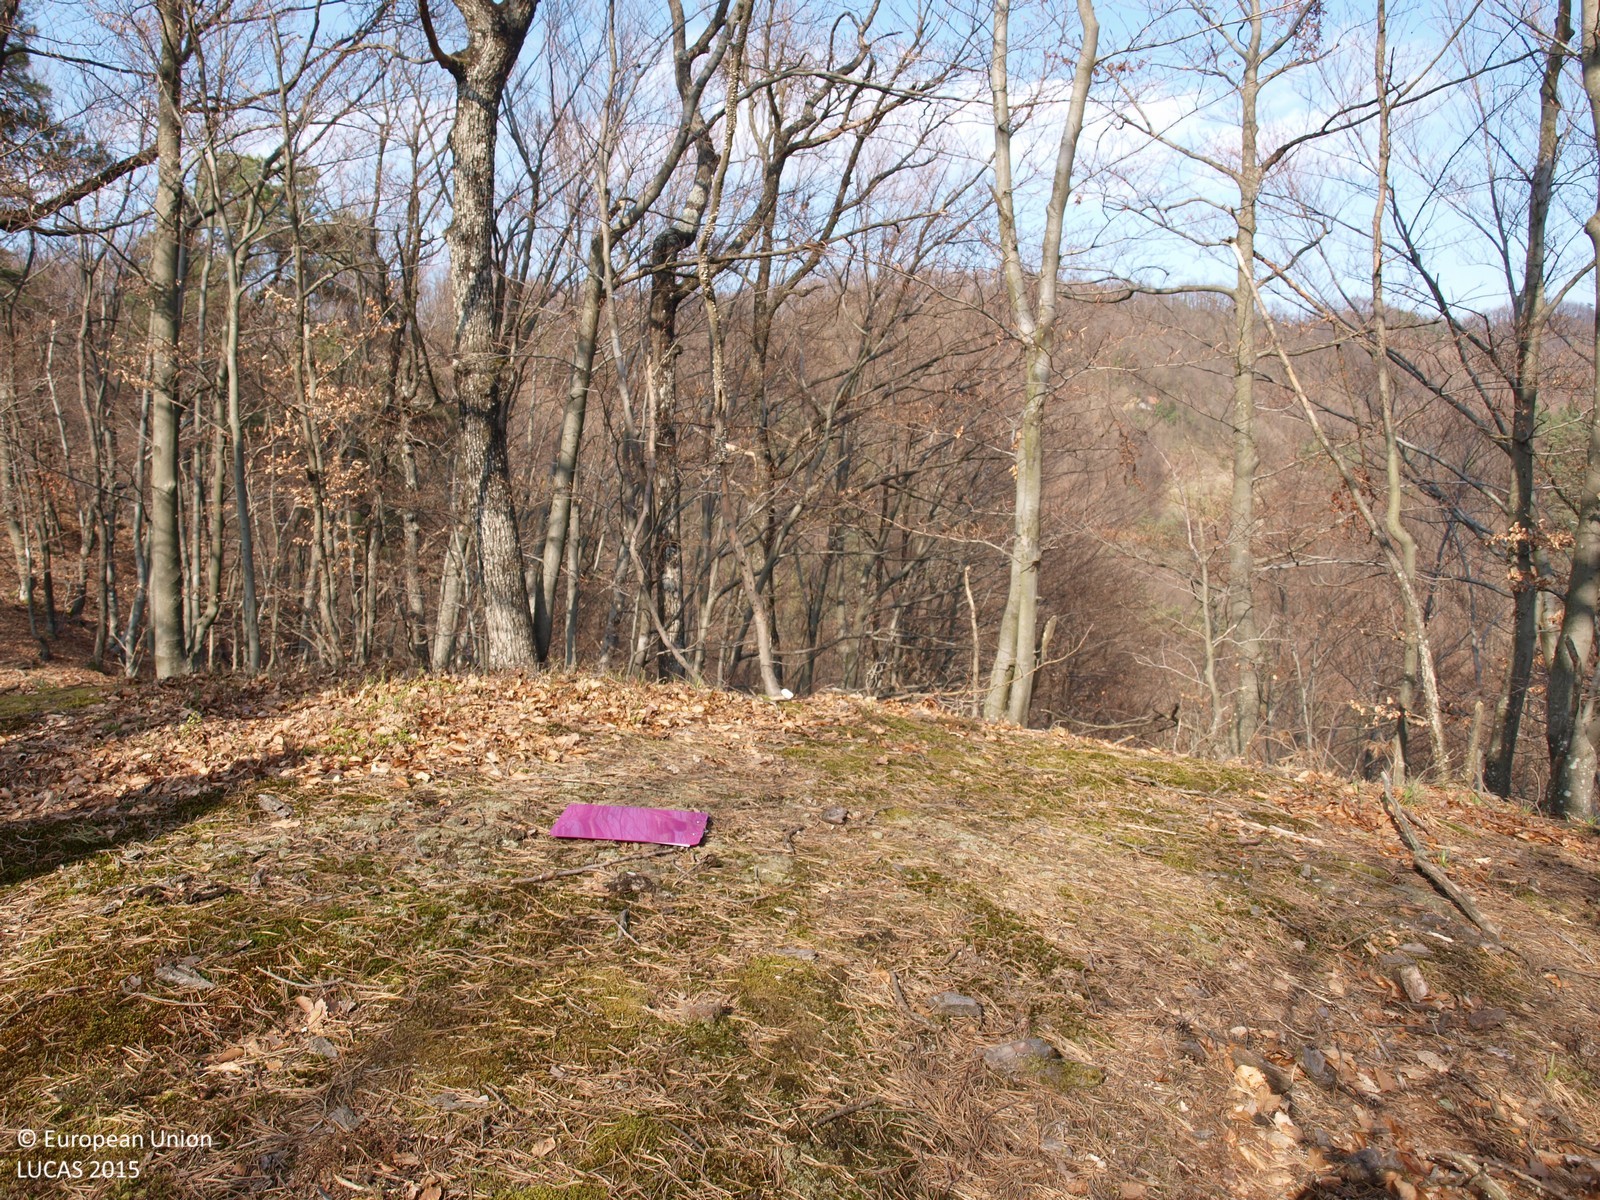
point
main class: Woodland
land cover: Broadleaved woodland
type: mesophytic deciduous forest
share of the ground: > 75 %
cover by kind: broadleaved forest trees 90 %, coniferous forest trees 10 %
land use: Forestry
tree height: > 5 m
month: March
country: HR
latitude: 46.2935
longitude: 15.9575
